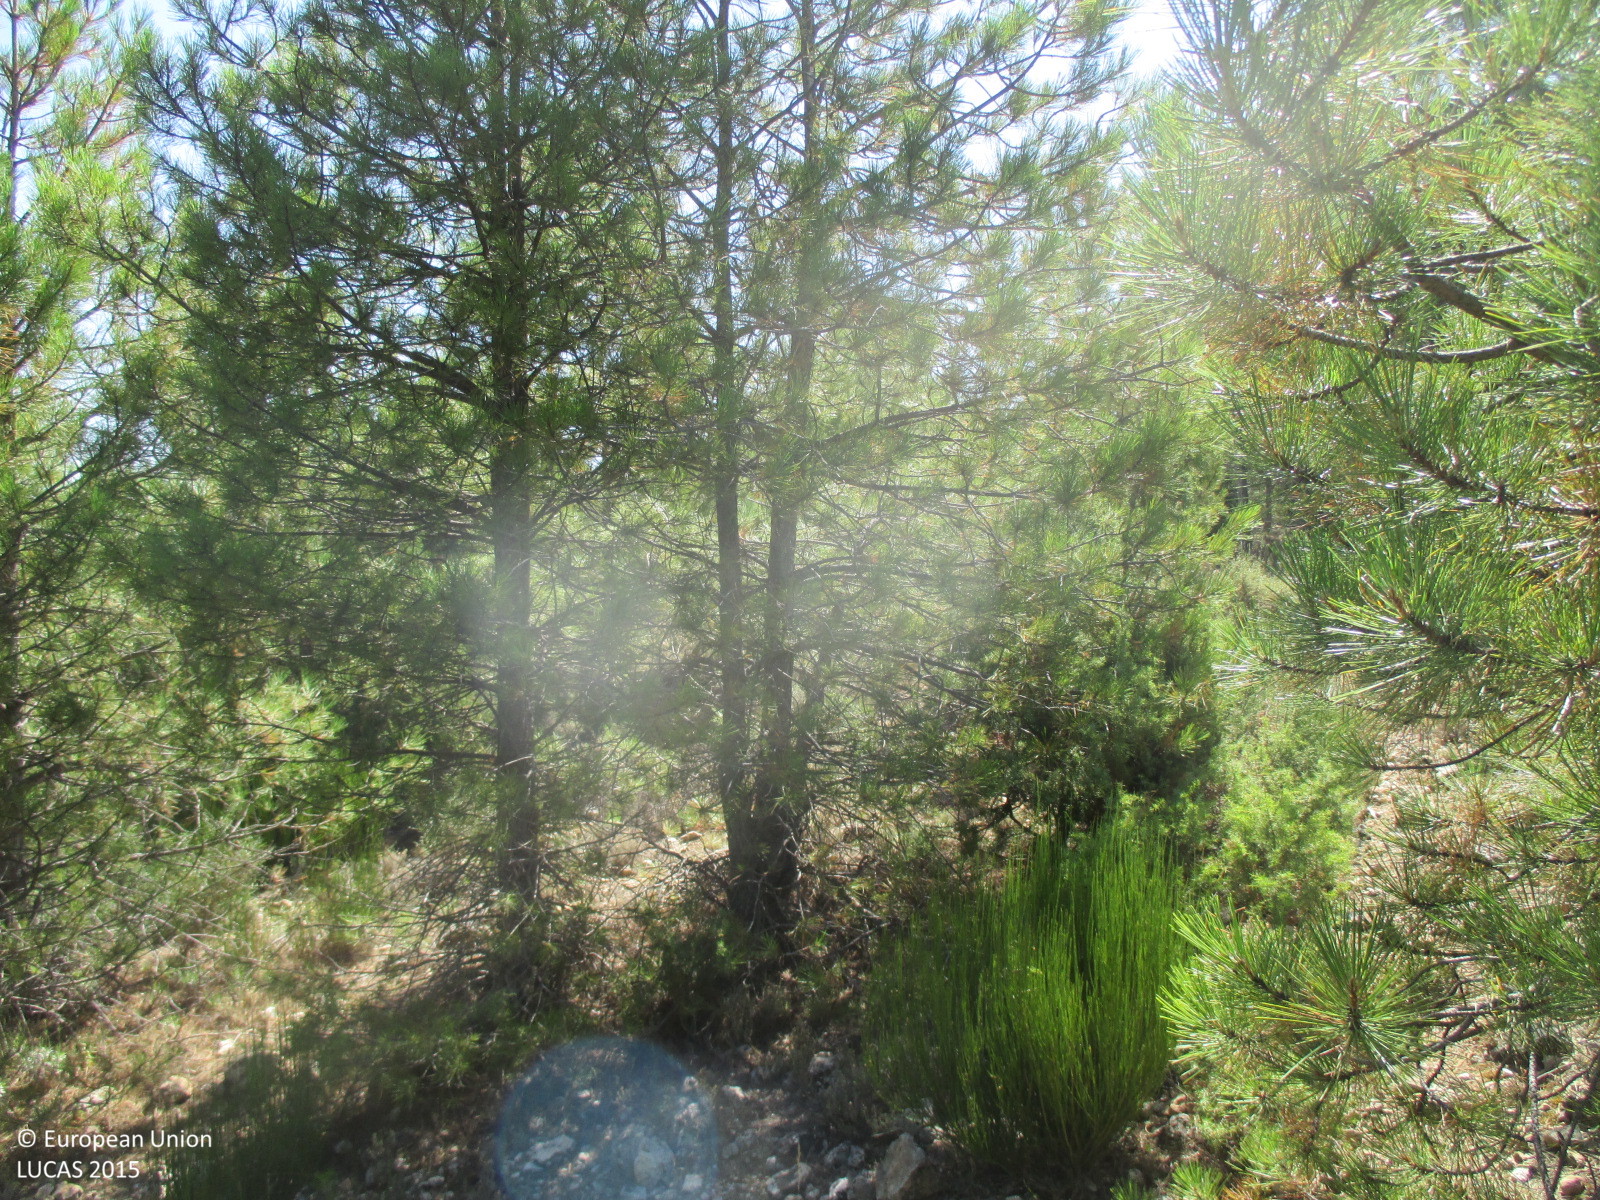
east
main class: Woodland
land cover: Pine dominated coniferous woodland
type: coniferous forest of the mediterranean region
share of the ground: 25 - 50 %
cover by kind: coniferous forest trees 40 %, shrubs 40 %, herbaceous plants 20 %
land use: Forestry
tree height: > 5 m
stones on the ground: < 10 %
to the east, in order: Pine dominated coniferous woodland; Tracks; Pine dominated coniferous woodland; Tracks; Pine dominated coniferous woodland
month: July
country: ES
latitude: 38.2761
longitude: -2.3518
